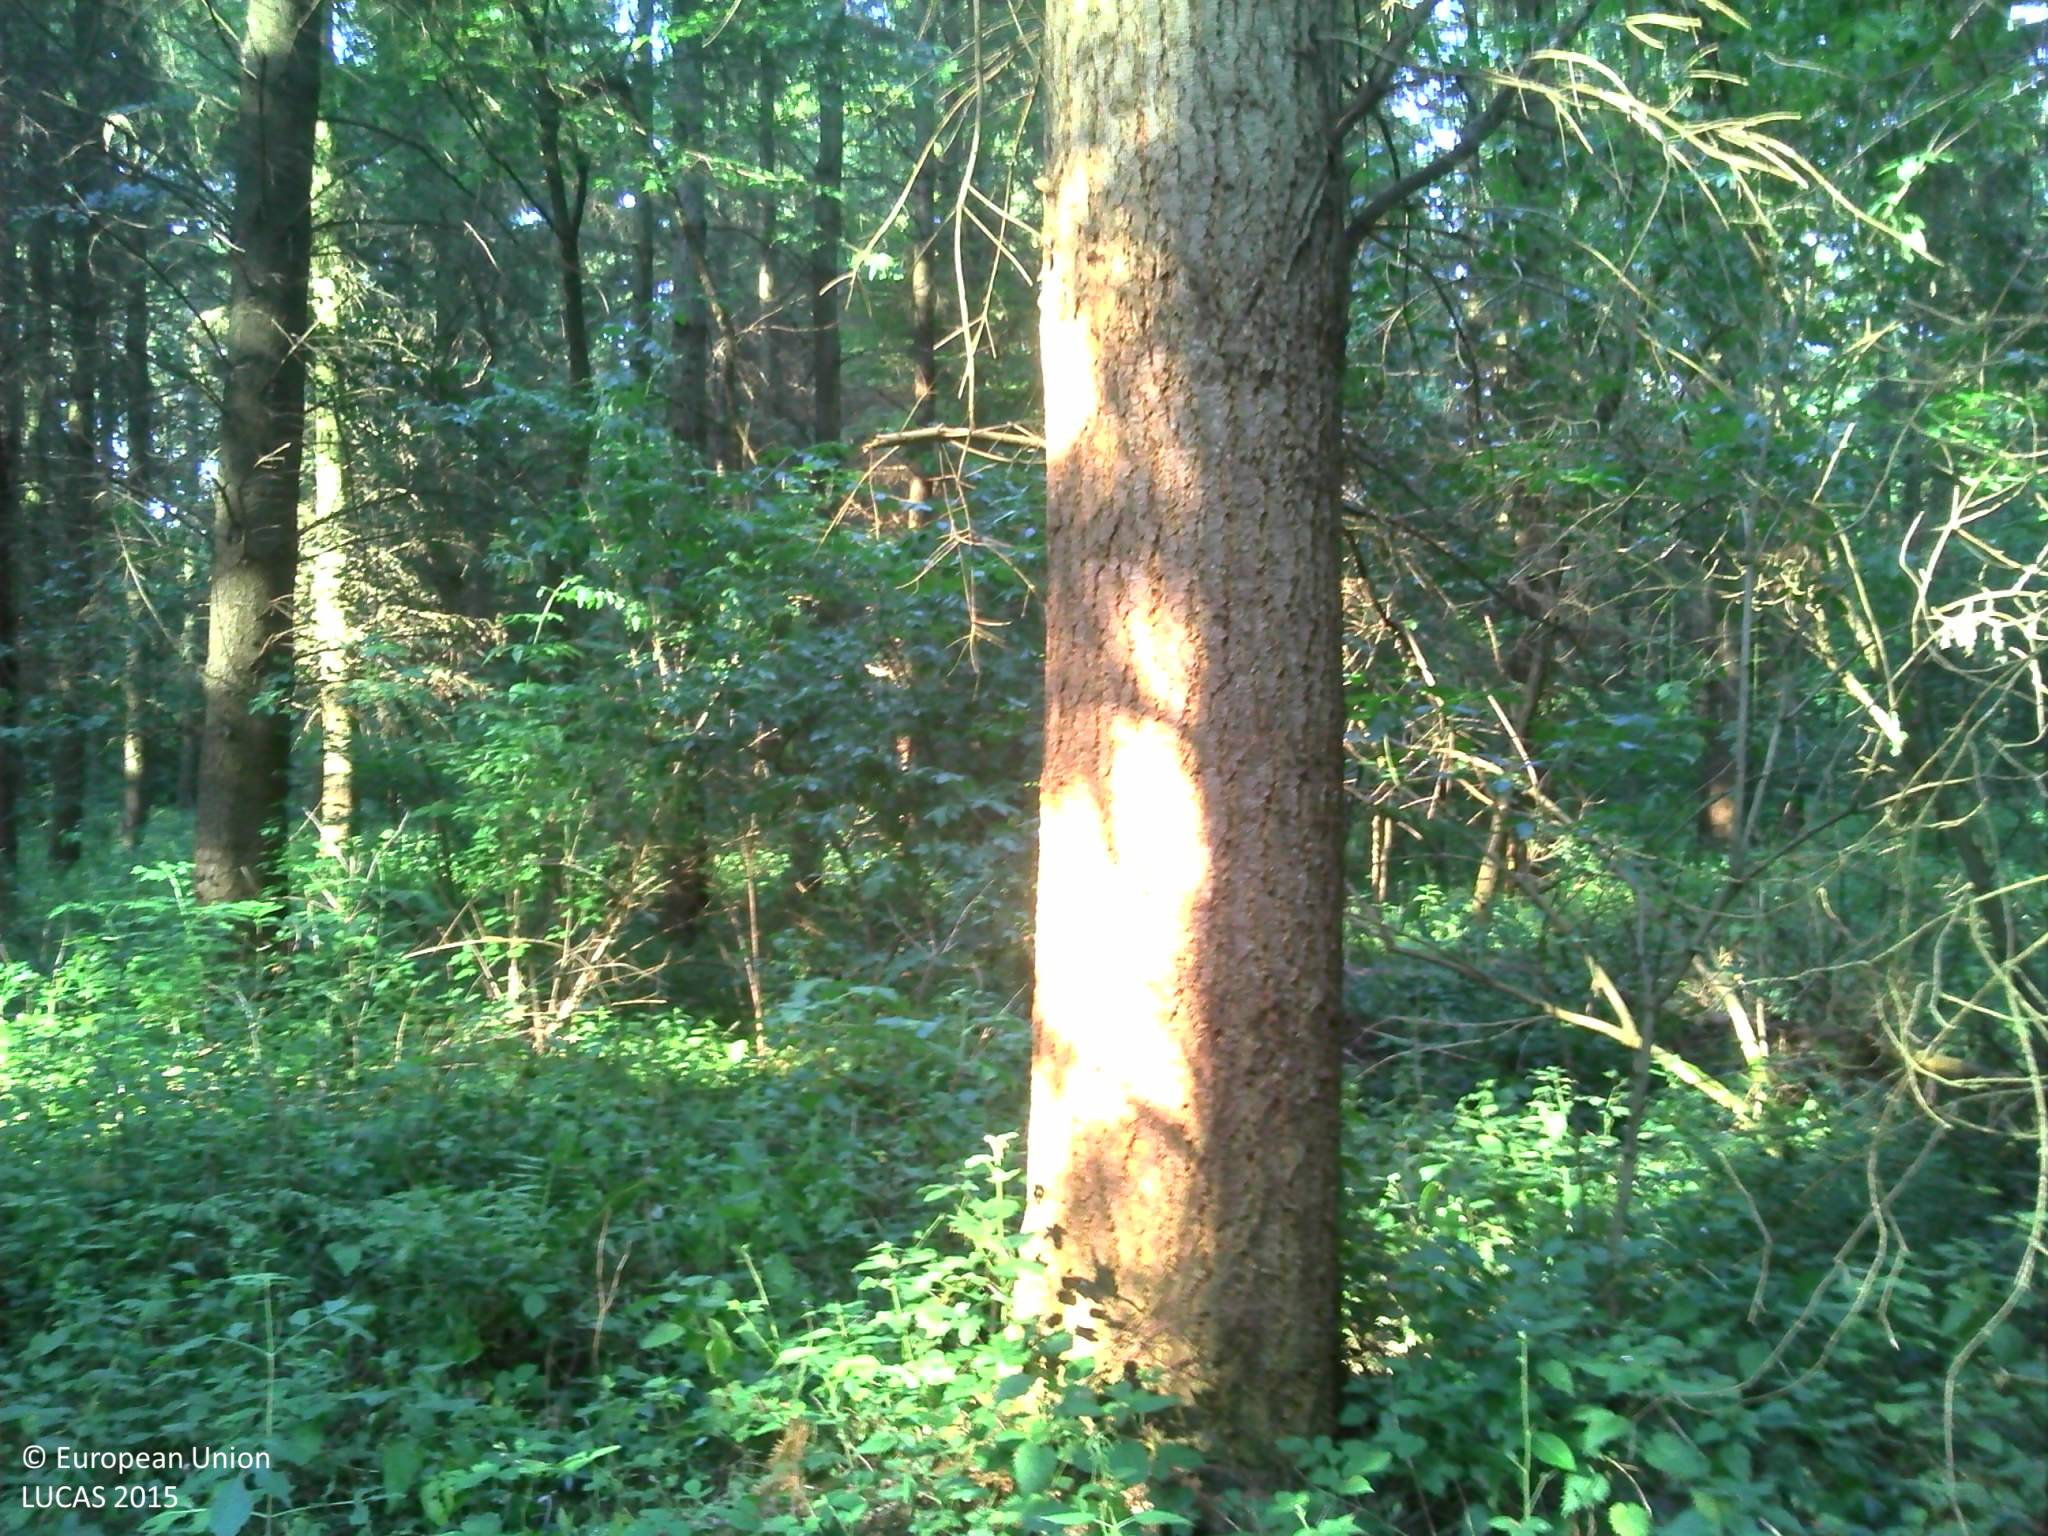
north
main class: Woodland
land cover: Spruce dominated mixed woodland
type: mesophytic deciduous forest
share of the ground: > 75 %
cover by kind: coniferous forest trees 45 %, broadleaved forest trees 20 %, consolidated bare surface 20 %, herbaceous plants 15 %
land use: Forestry
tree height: > 5 m
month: July
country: FR
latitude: 48.8761
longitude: 1.3229
